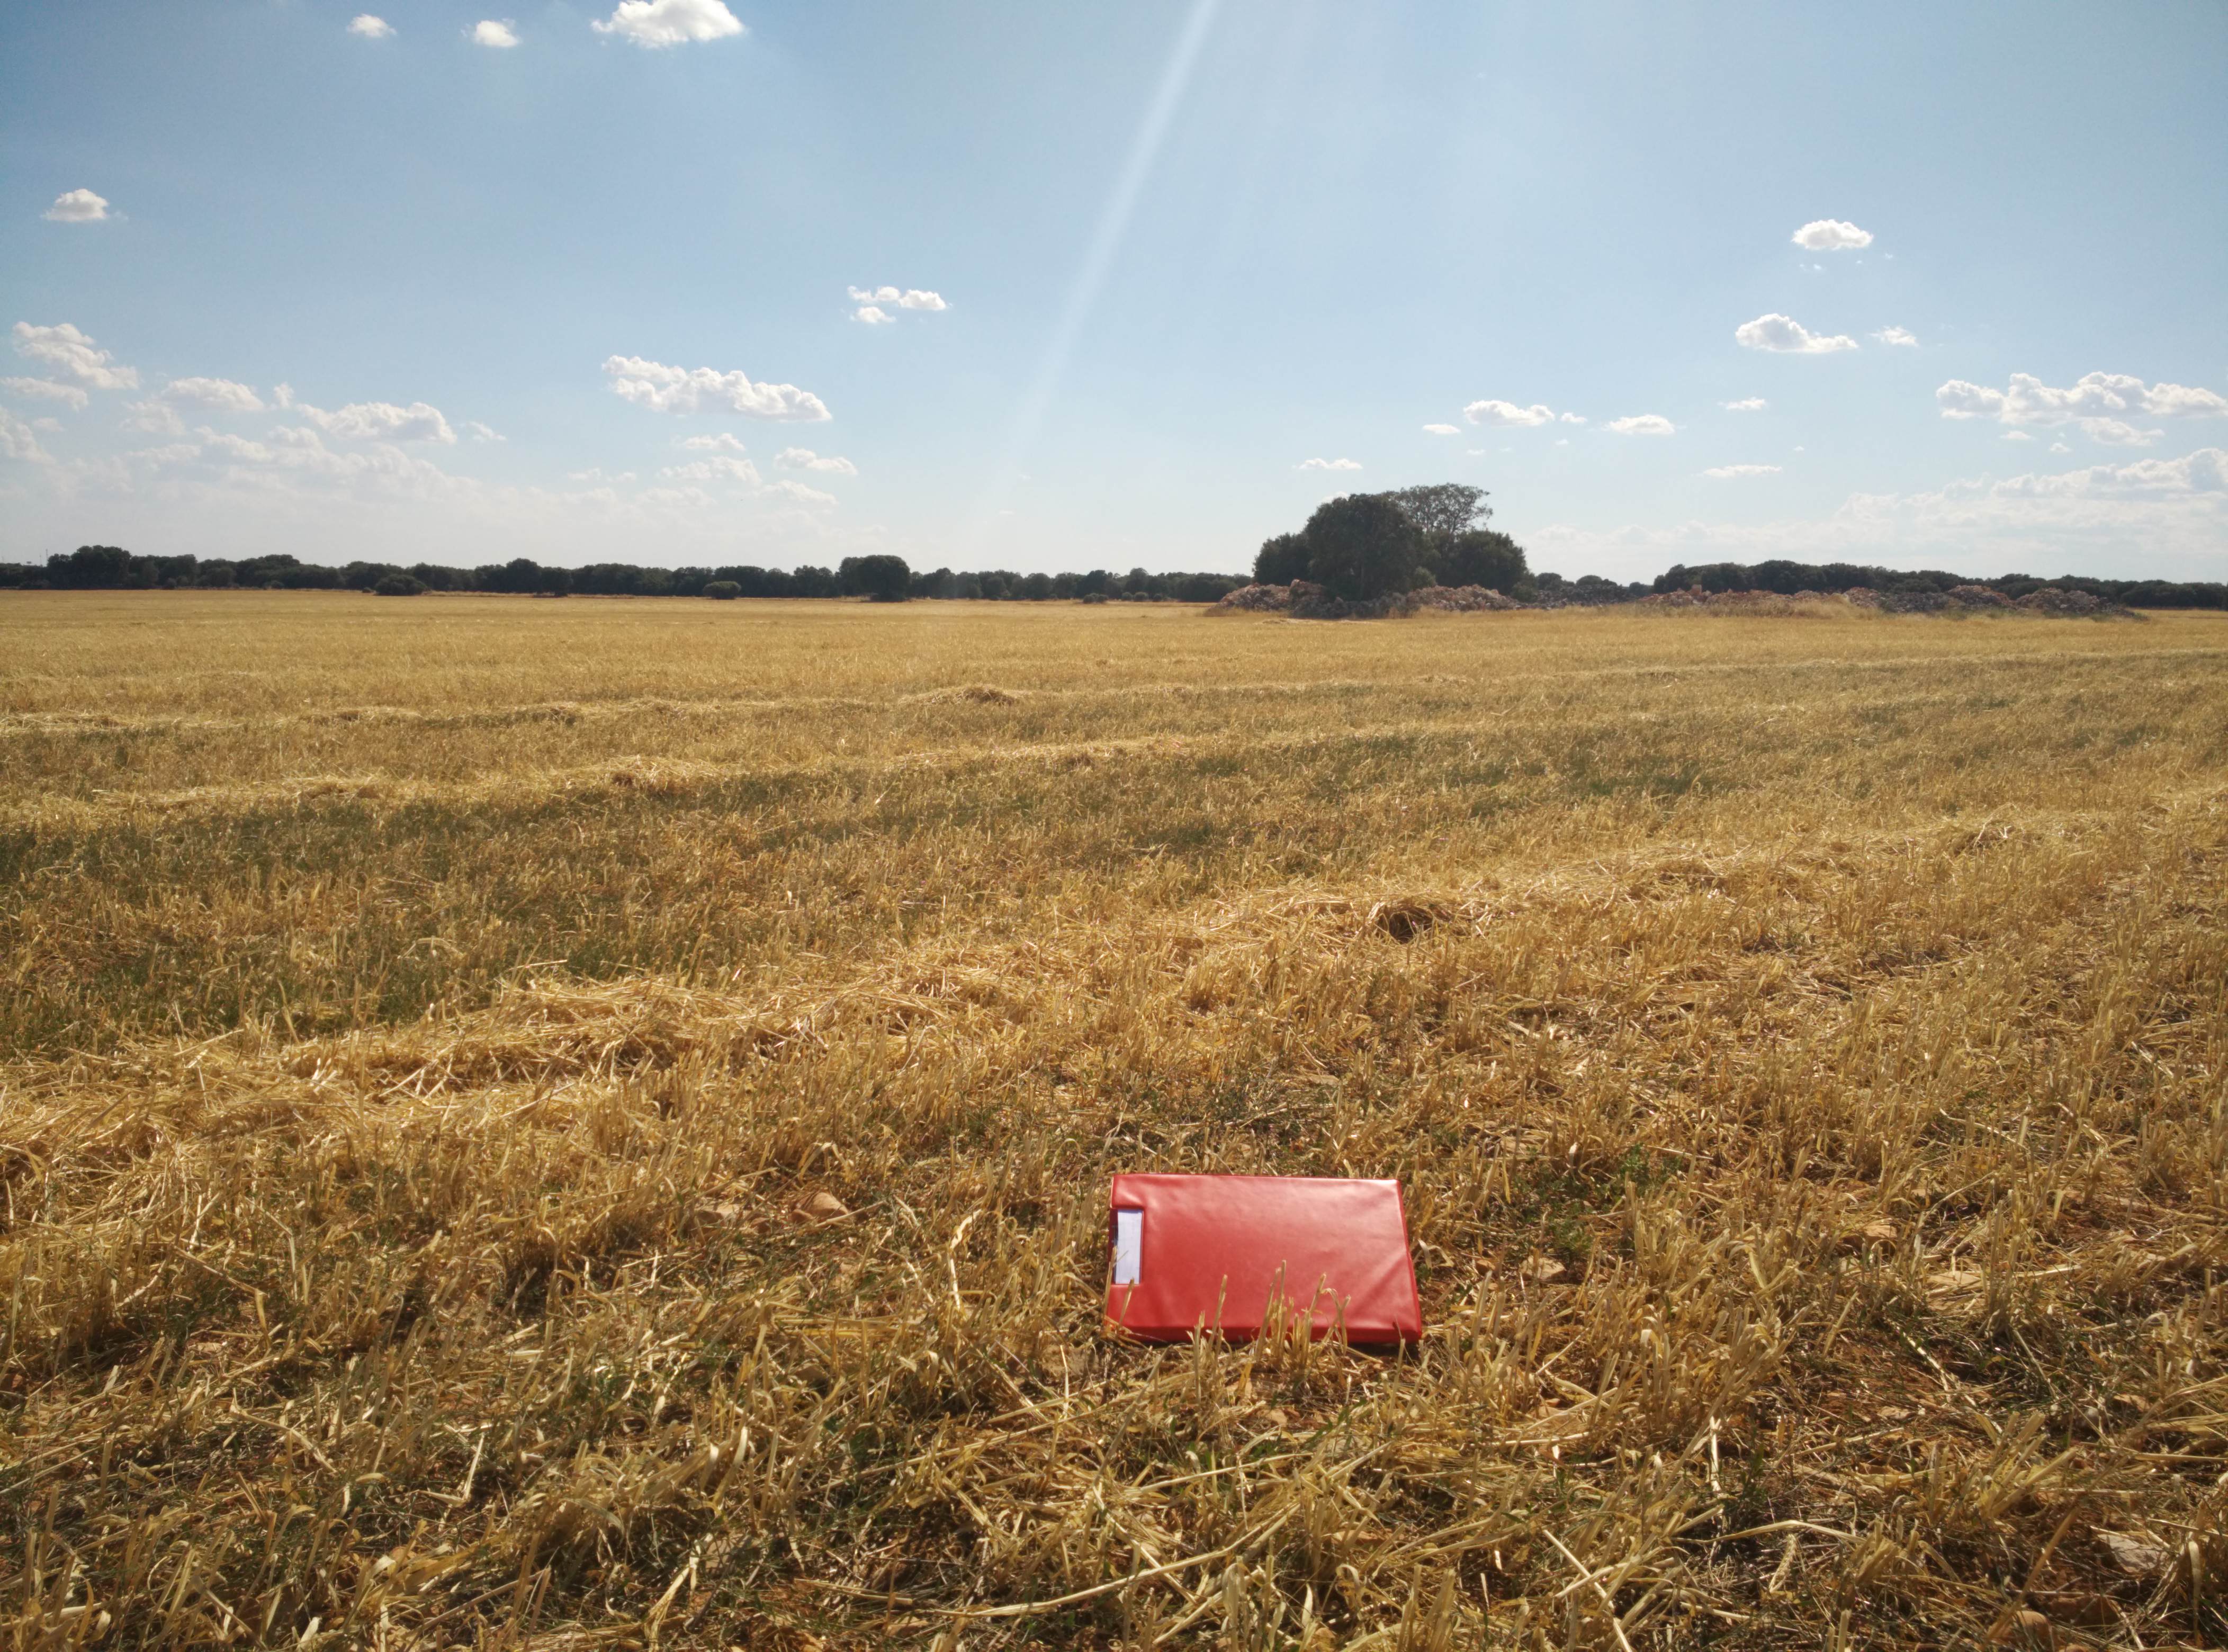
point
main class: Cropland
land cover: Barley
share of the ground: < 10 %
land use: Agriculture (excluding fallow land and kitchen gardens)
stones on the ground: > 50 %
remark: Harvested field
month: July
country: ES
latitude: 40.9340
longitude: -2.7280
